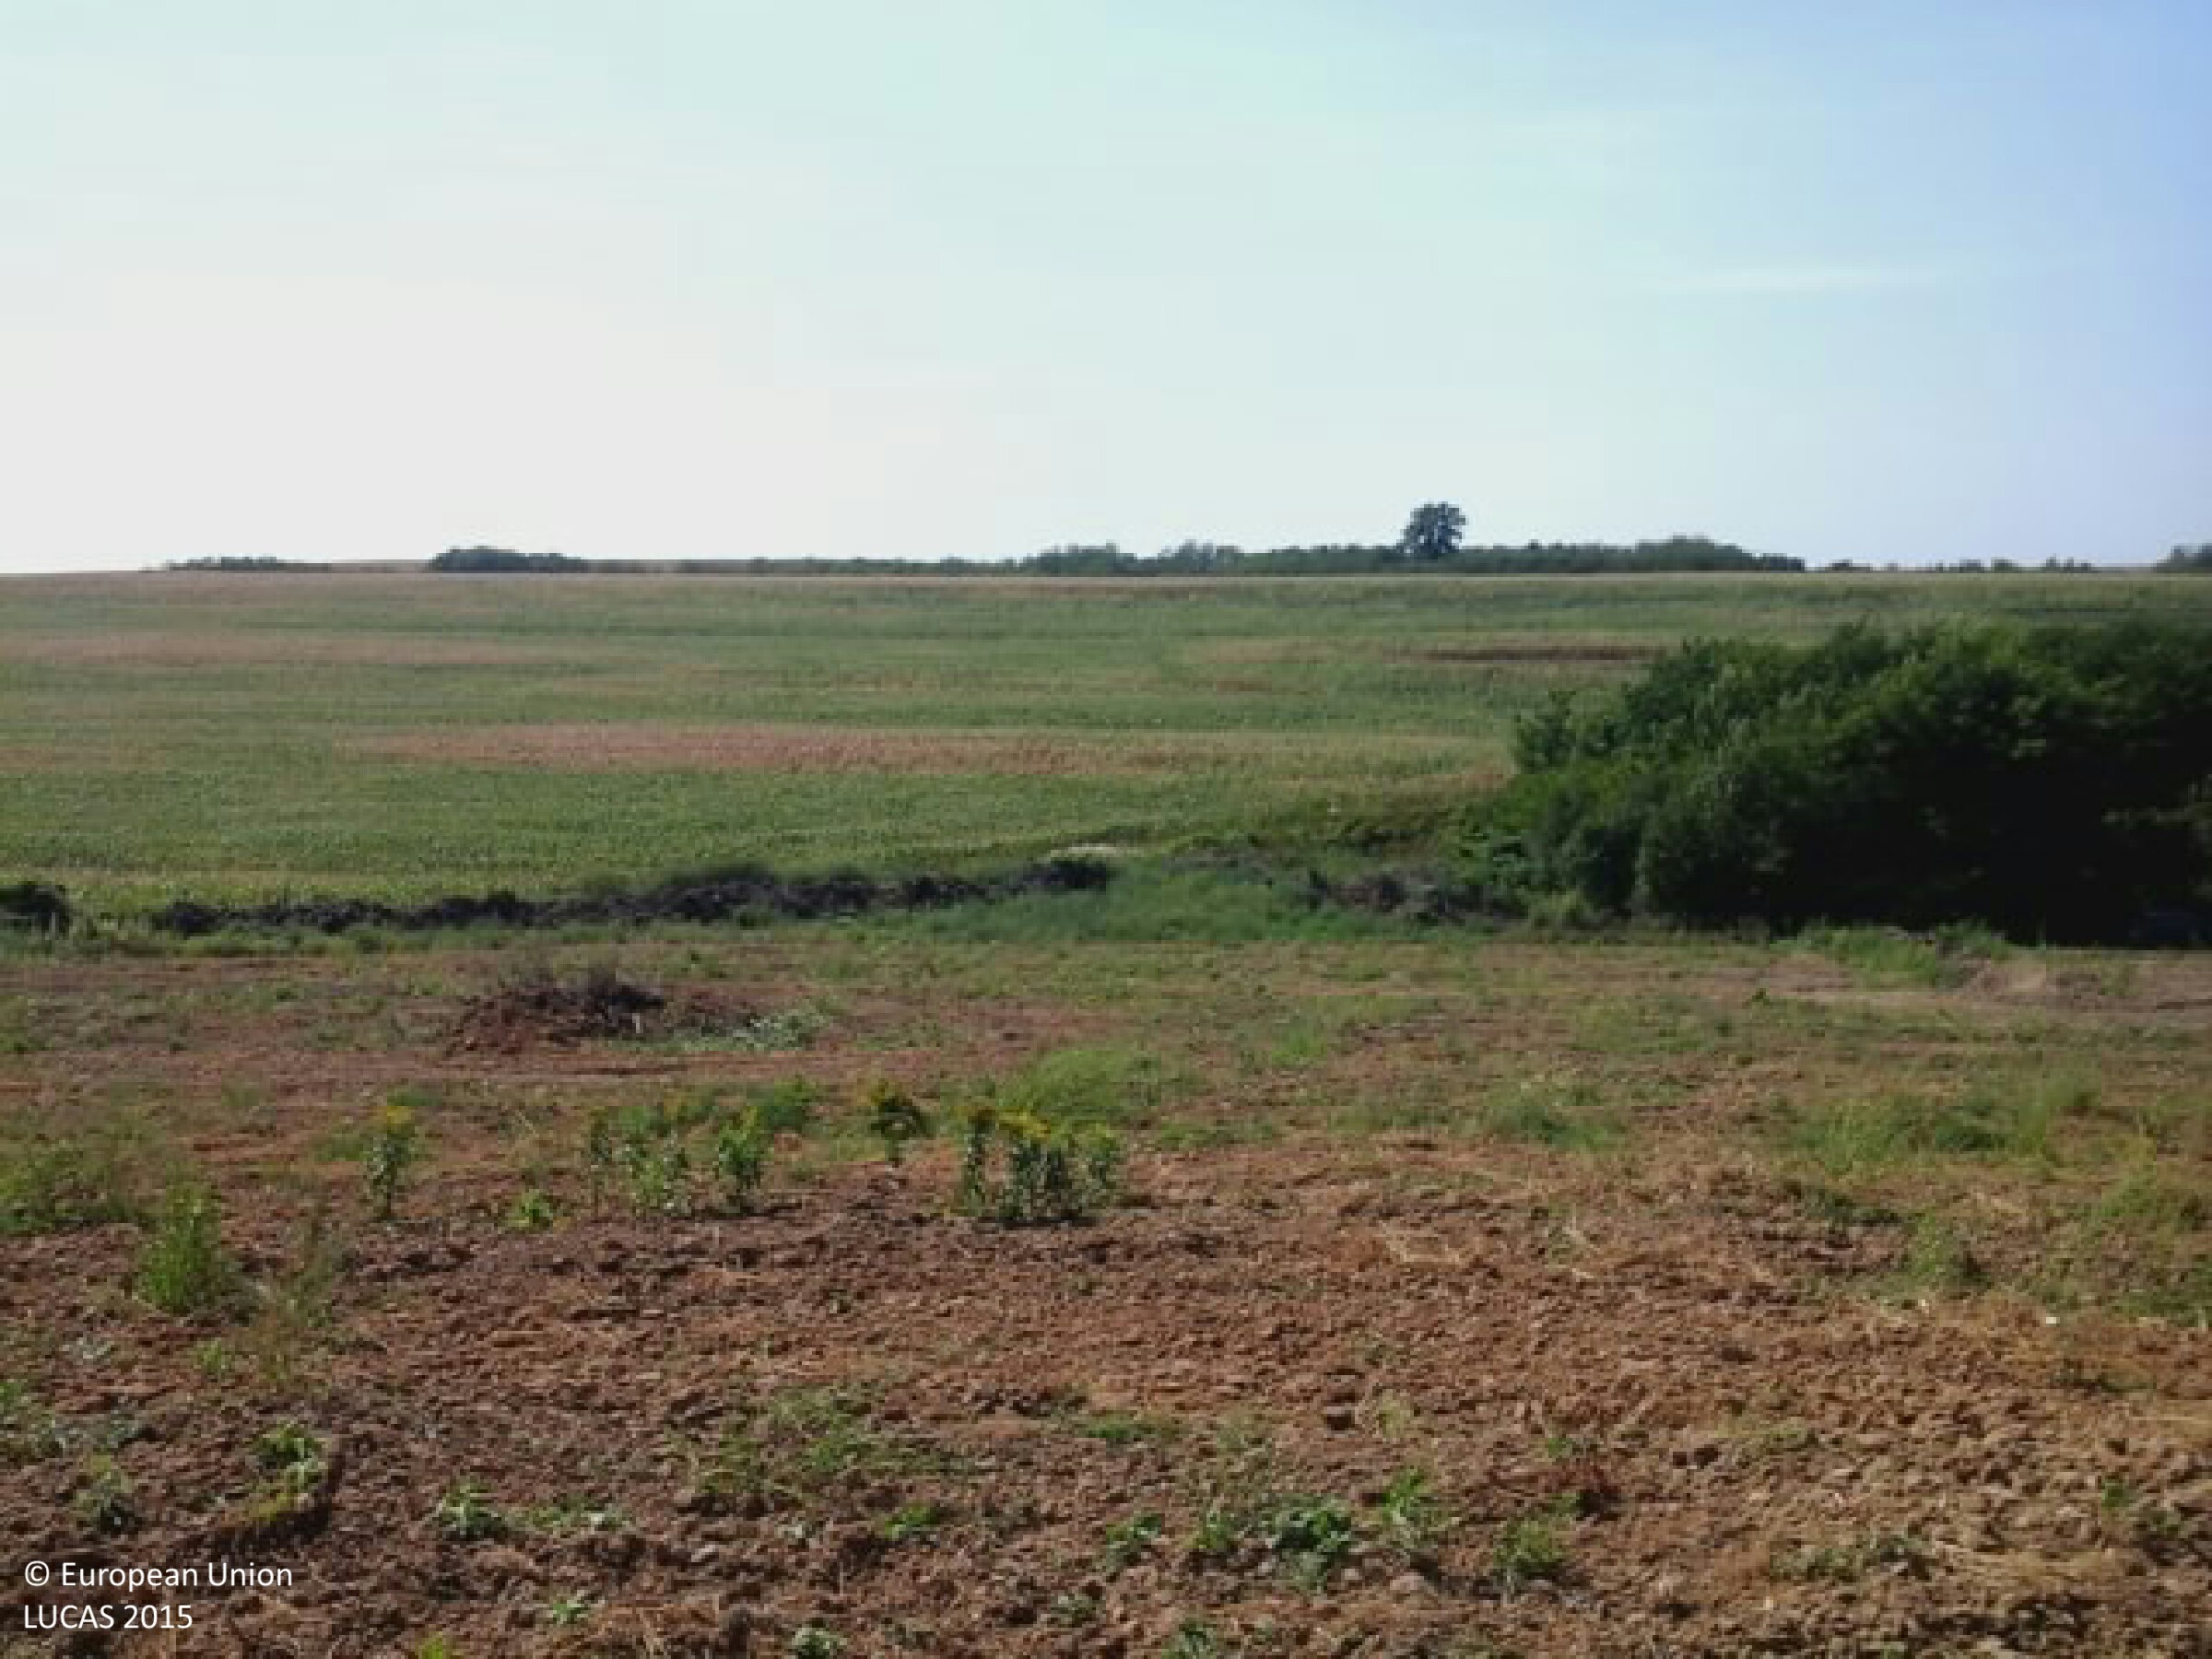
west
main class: Grassland
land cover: Spontaneously vegetated surfaces
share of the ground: 10 - 25 %
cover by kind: unconsolidated bare surface 90 %, herbaceous plants 10 %
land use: Fallow land
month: May
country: HU
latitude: 46.3119
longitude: 17.6535
